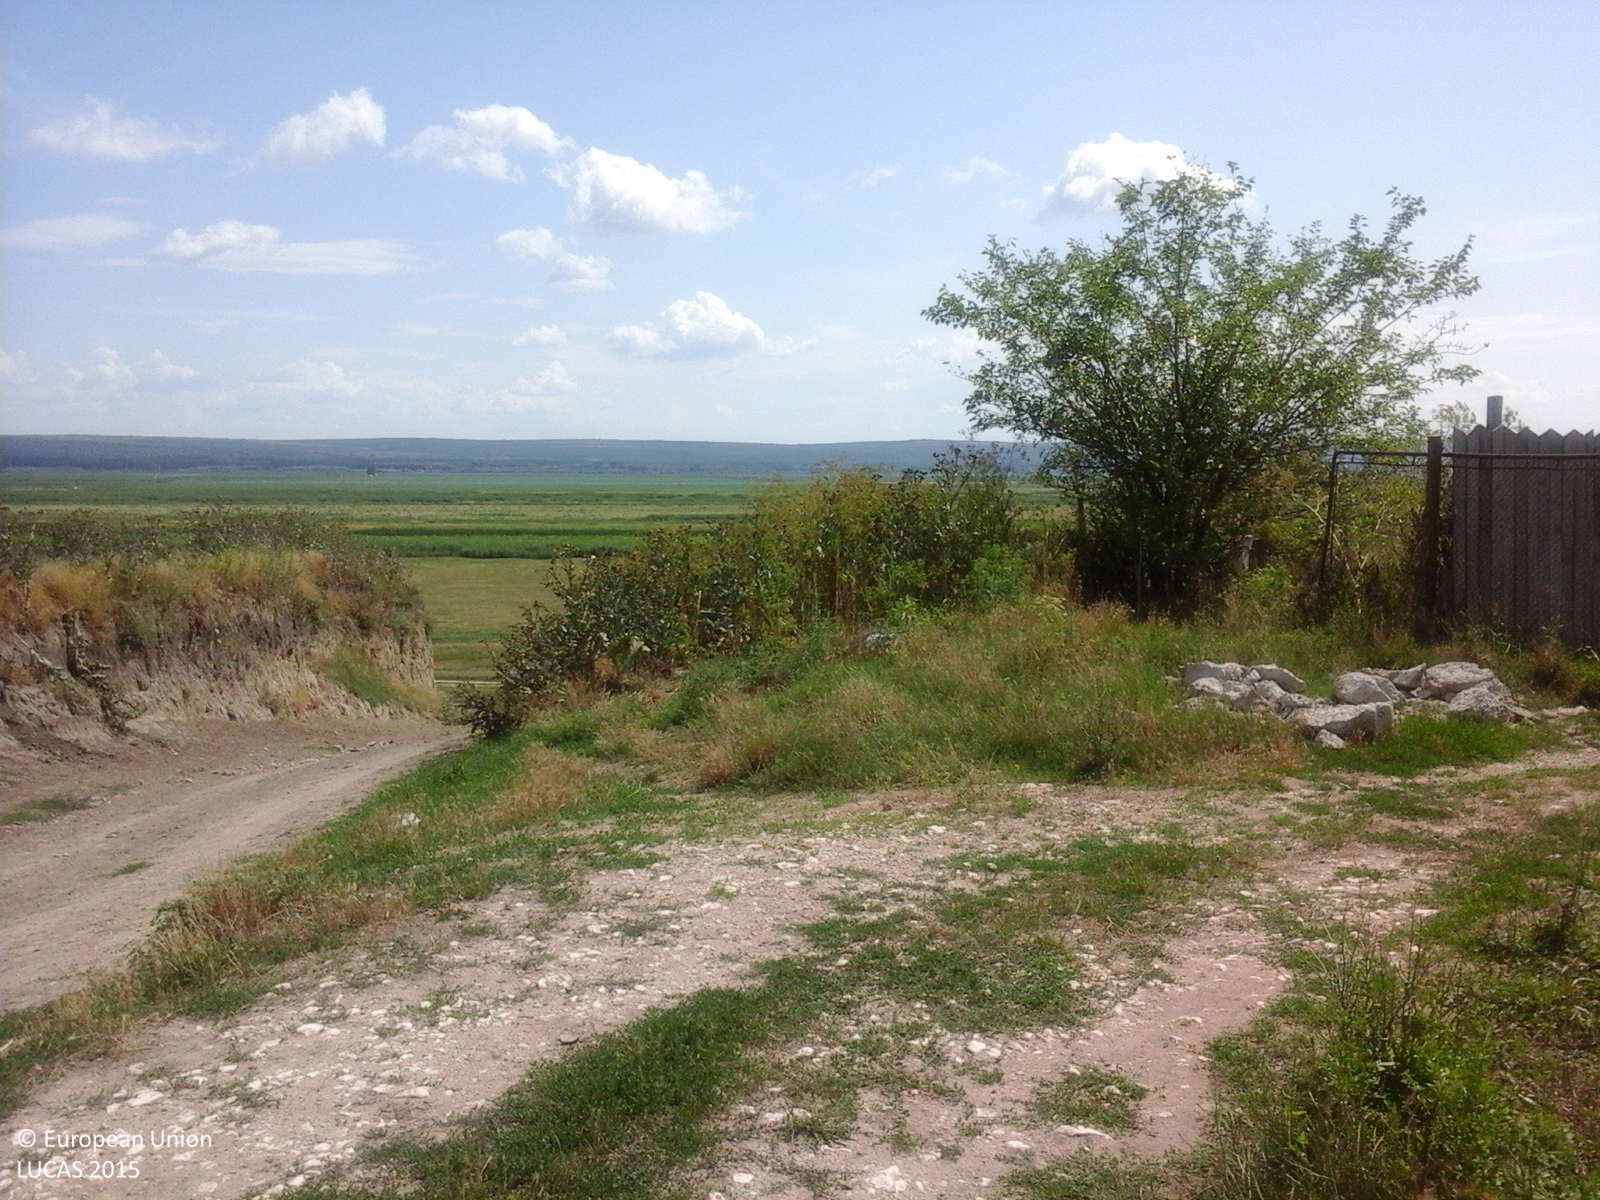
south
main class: Grassland
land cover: Grassland without tree/shrub cover
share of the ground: > 75 %
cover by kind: herbaceous plants 100 %
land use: Agriculture (excluding fallow land and kitchen gardens)
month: July
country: RO
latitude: 43.7489
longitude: 24.3552
